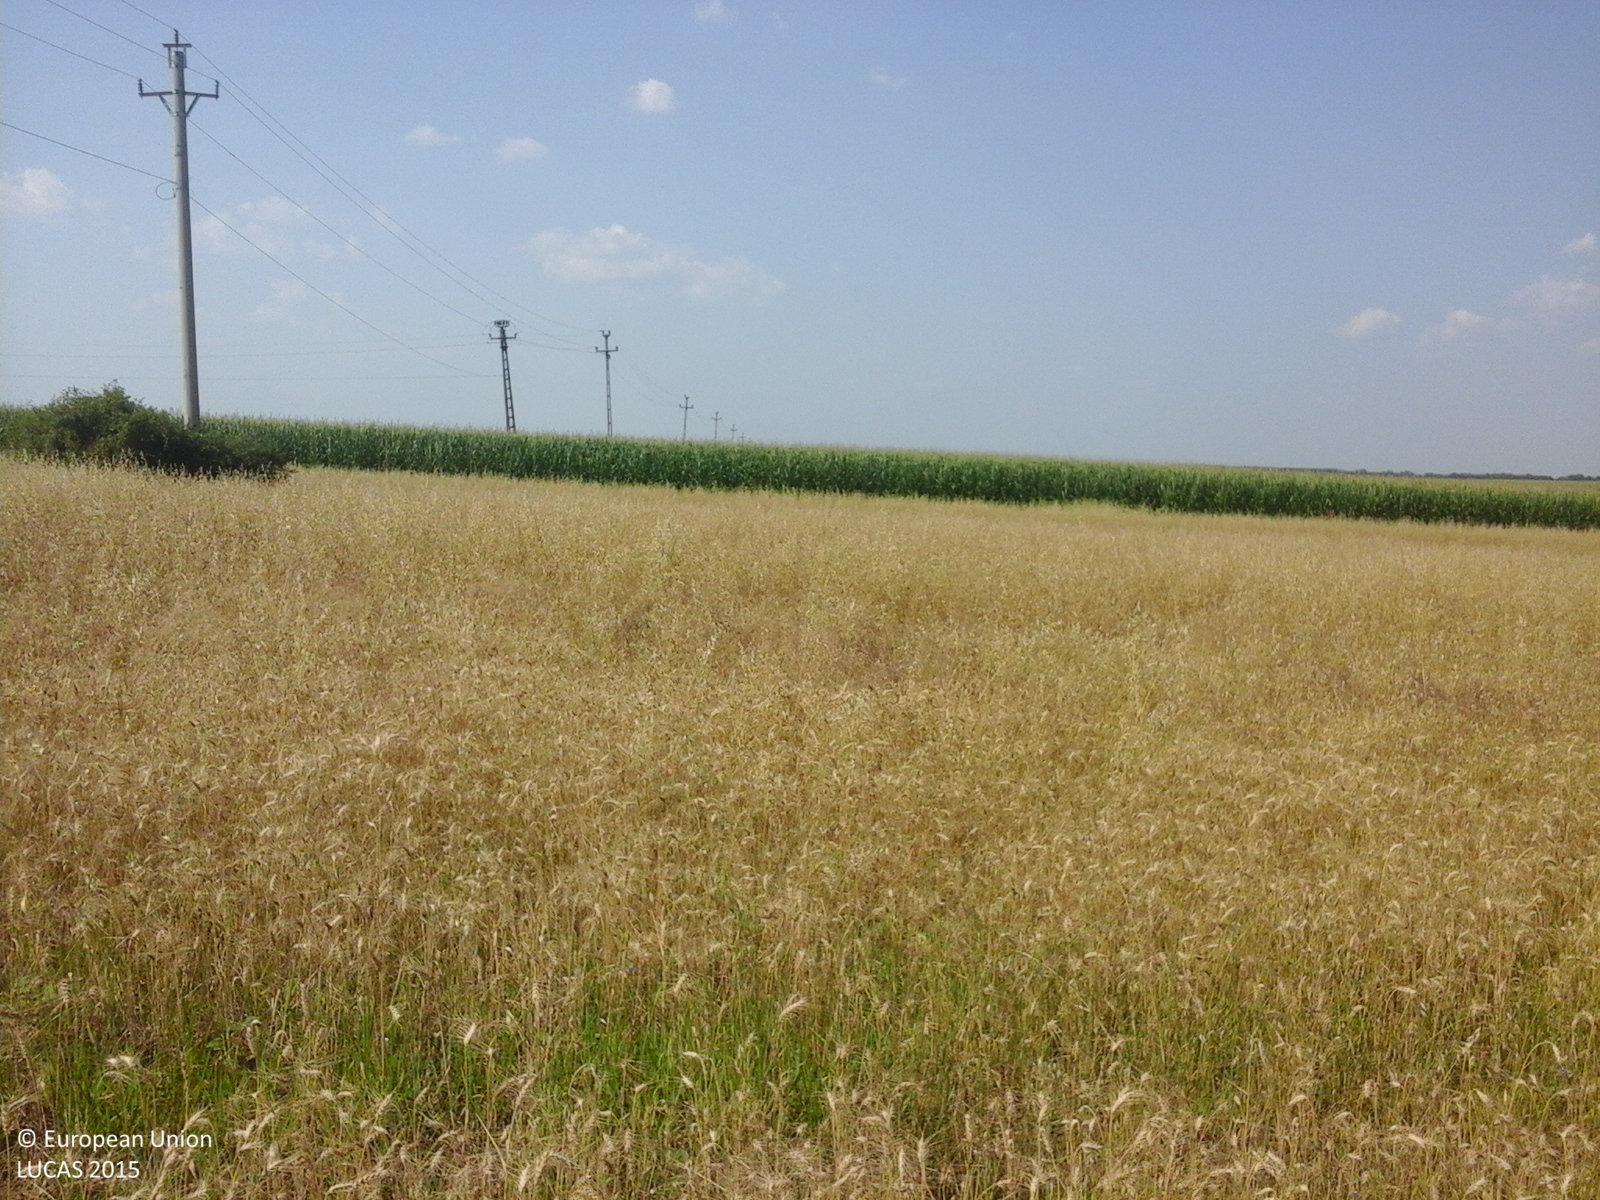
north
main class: Cropland
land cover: Maize
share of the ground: > 75 %
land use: Agriculture (excluding fallow land and kitchen gardens)
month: July
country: RO
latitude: 44.6598
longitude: 24.5129
